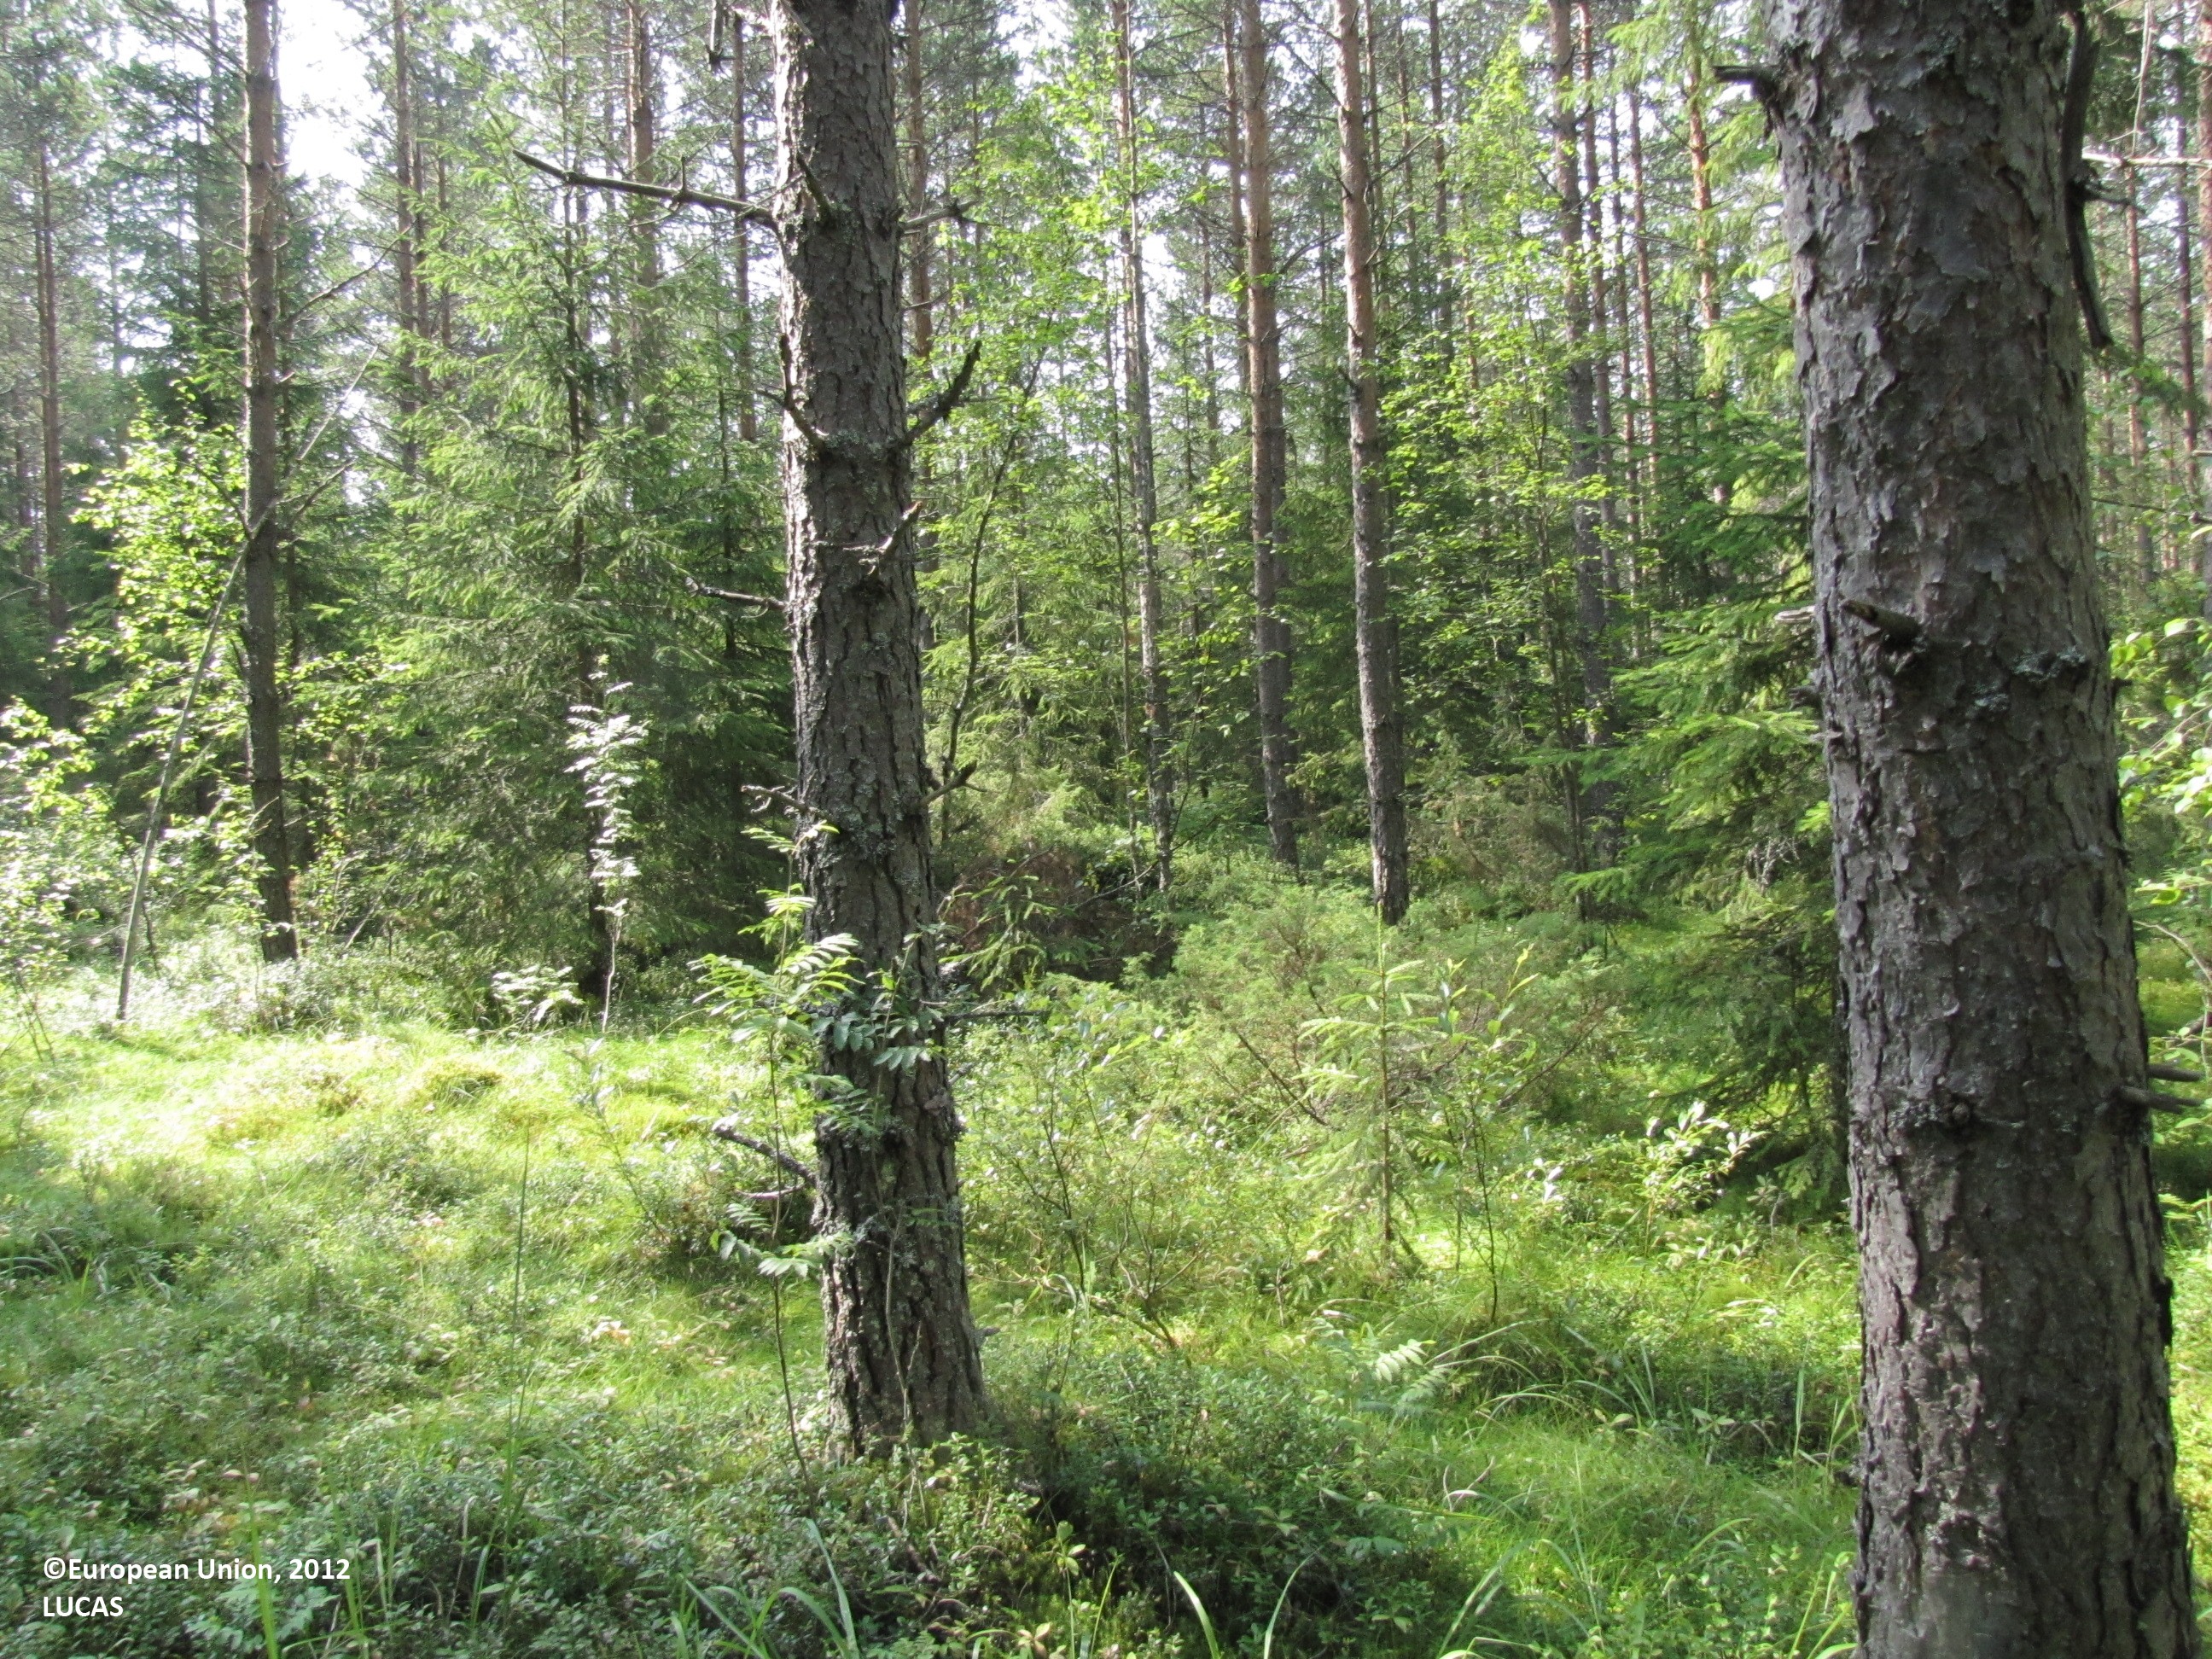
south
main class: Woodland
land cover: Other coniferous woodland
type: boreal forest
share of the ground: 50 - 75 %
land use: Forestry
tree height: > 5 m
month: July
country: FI
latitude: 62.0037
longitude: 23.2668
